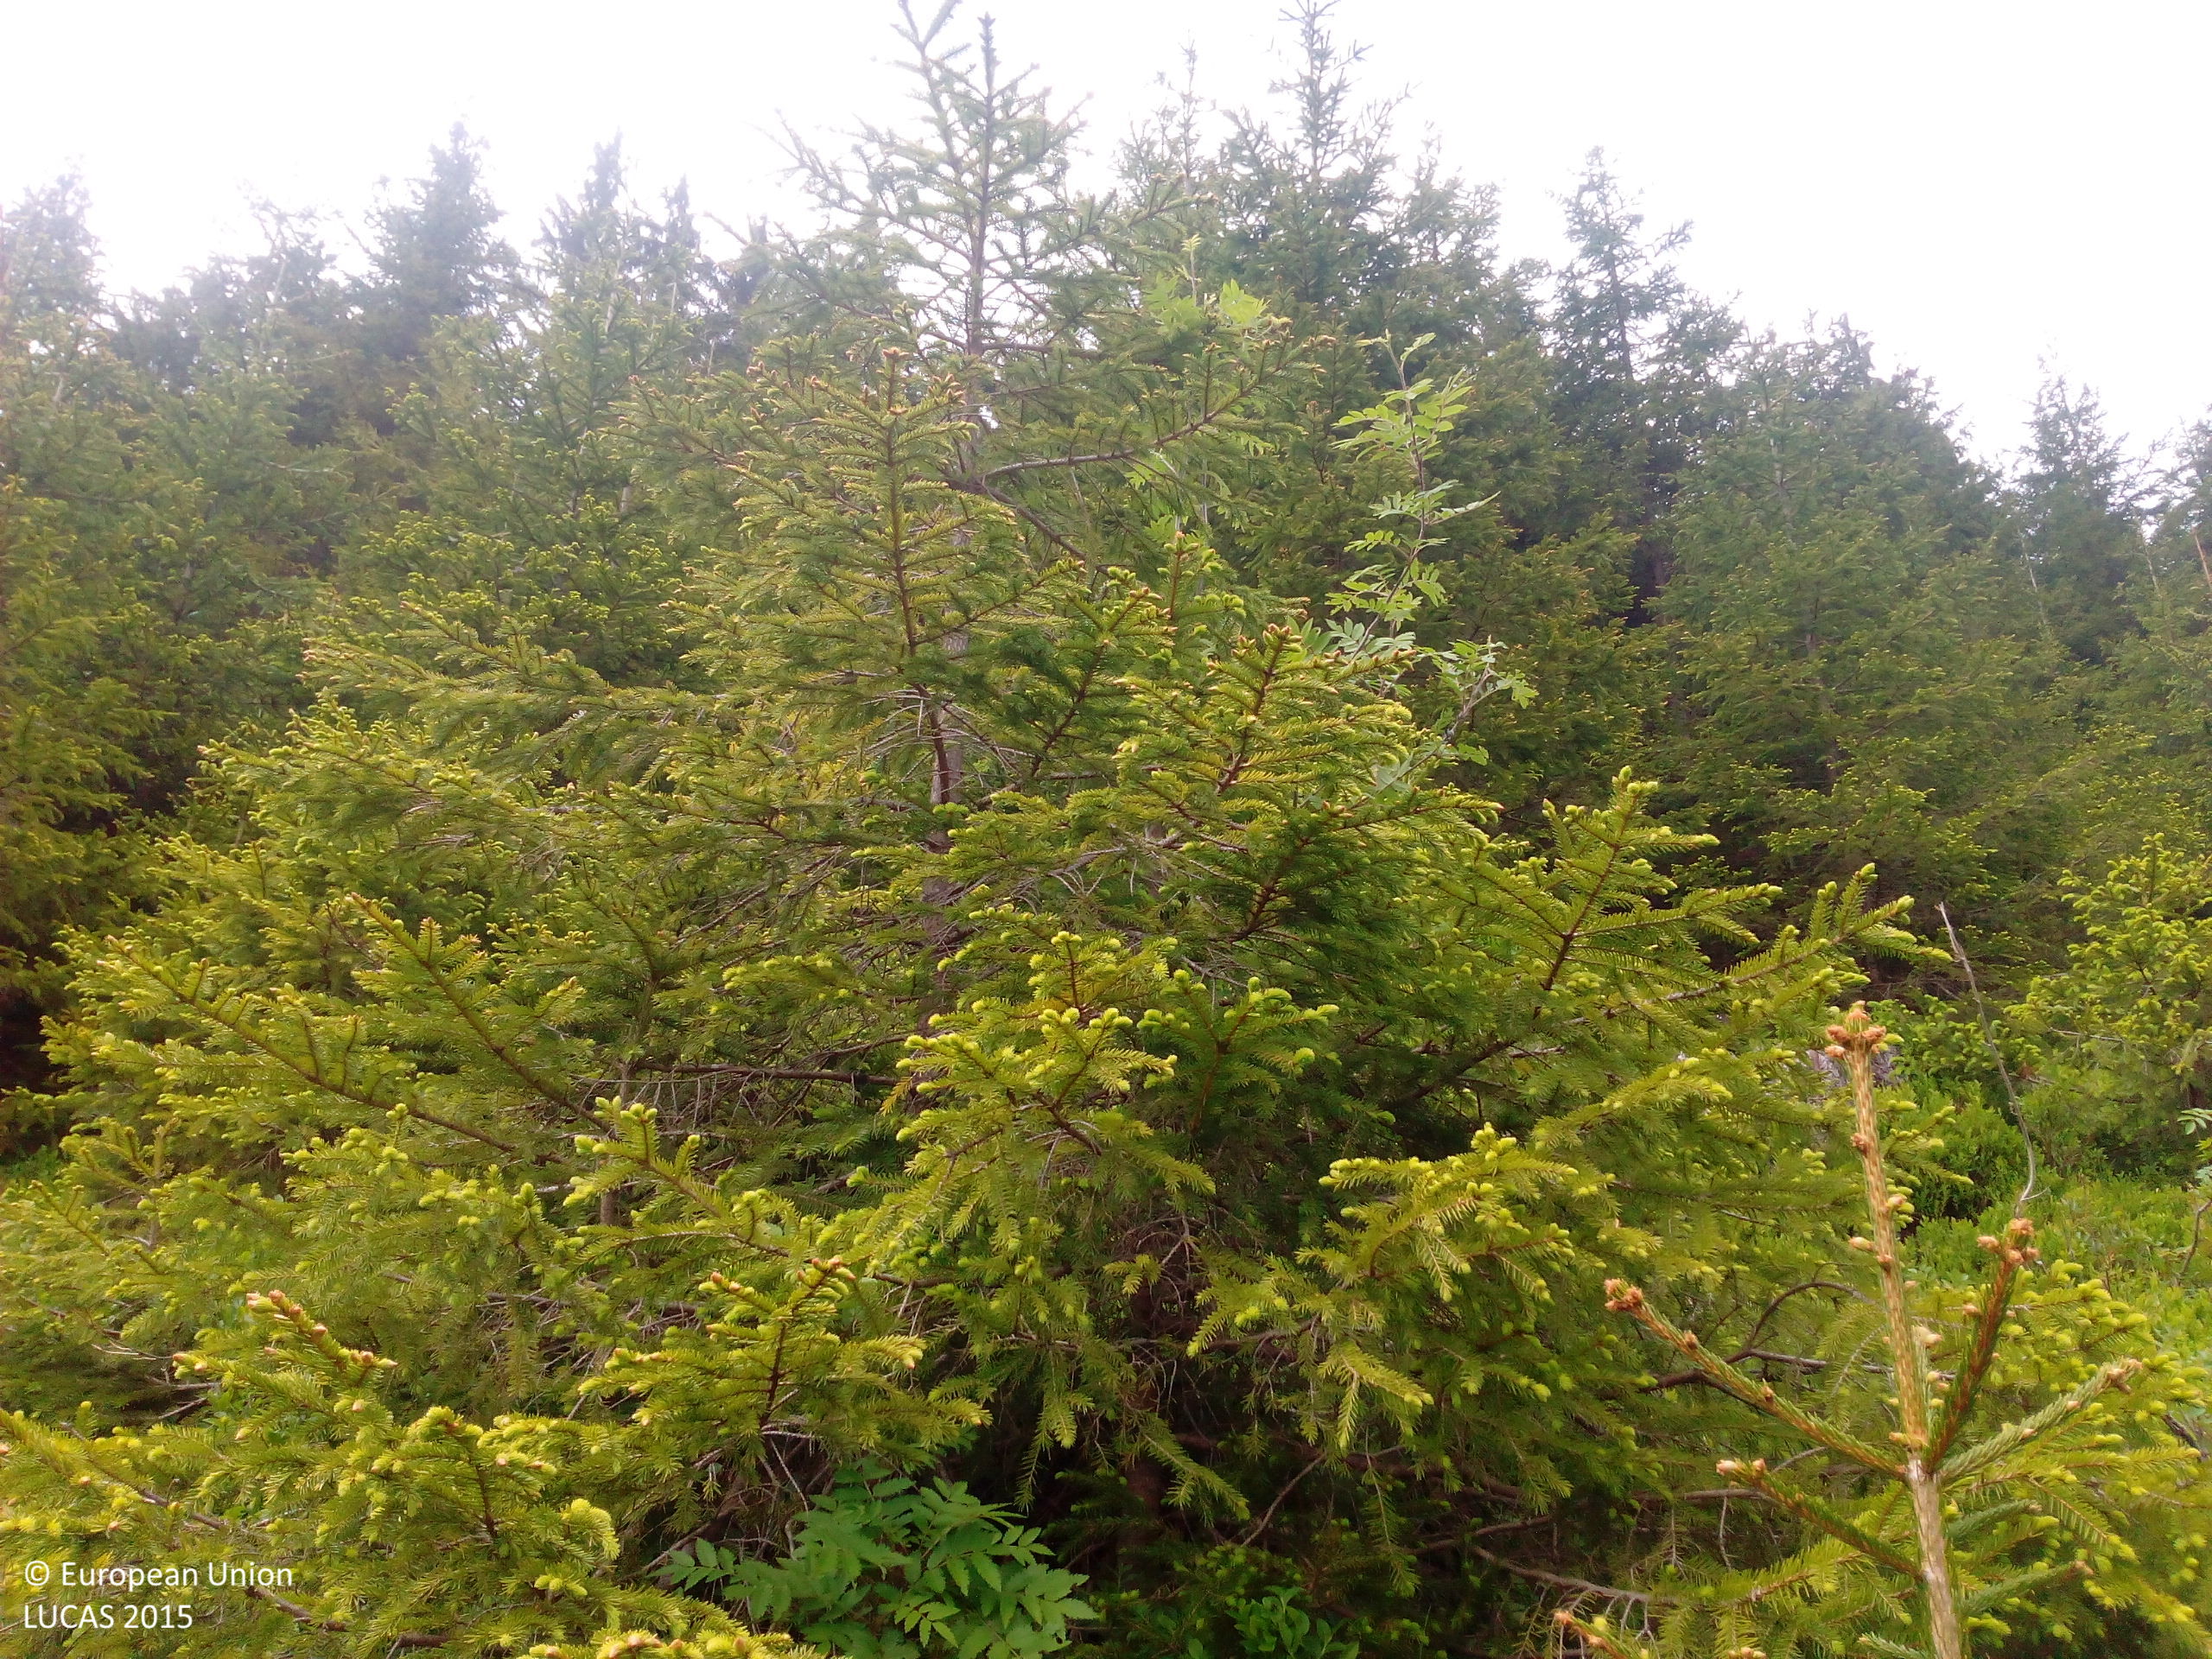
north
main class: Woodland
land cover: Spruce dominated coniferous woodland
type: hemiboreal forest and nemoral coniferous forest and mixed broadleaved-coniferous forest
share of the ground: 25 - 50 %
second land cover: Shrubland without tree cover
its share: 50 - 75 %
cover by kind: coniferous forest trees 40 %, shrubs 40 %, herbaceous plants 20 %
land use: Forestry
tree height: < 5 m
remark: Clear cut
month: May
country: DE
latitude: 48.0647
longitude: 8.1894
